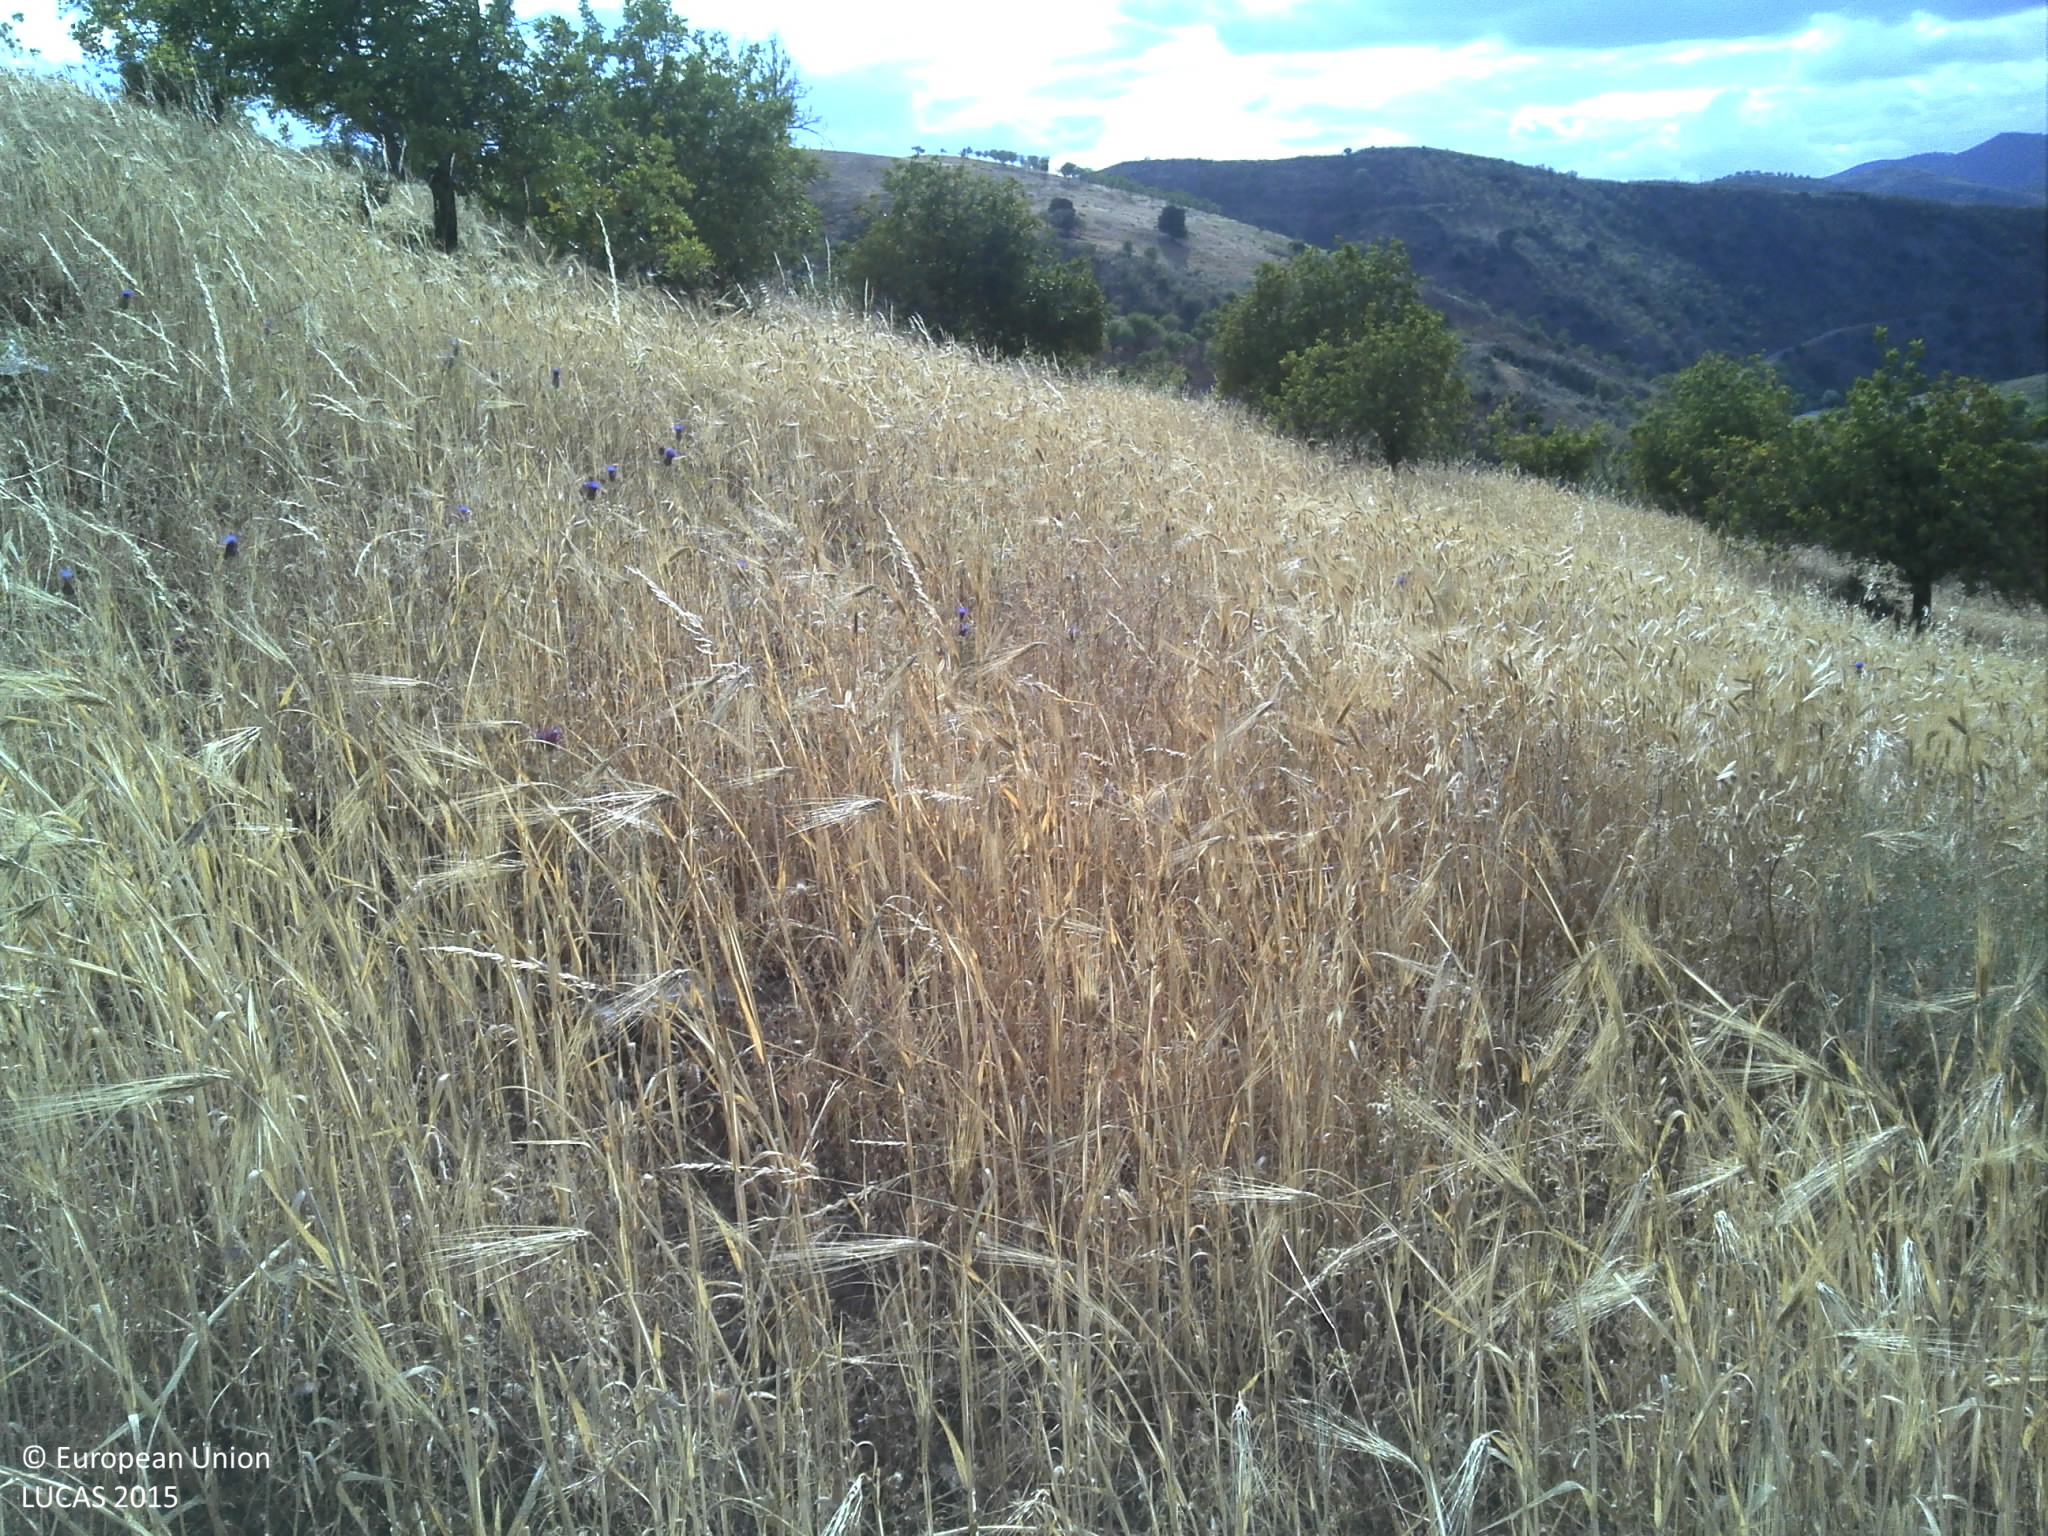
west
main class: Cropland
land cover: Nuts trees
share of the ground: 25 - 50 %
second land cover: Barley
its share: > 75 %
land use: Agriculture (excluding fallow land and kitchen gardens)
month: June
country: PT
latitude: 37.3277
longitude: -7.7176
